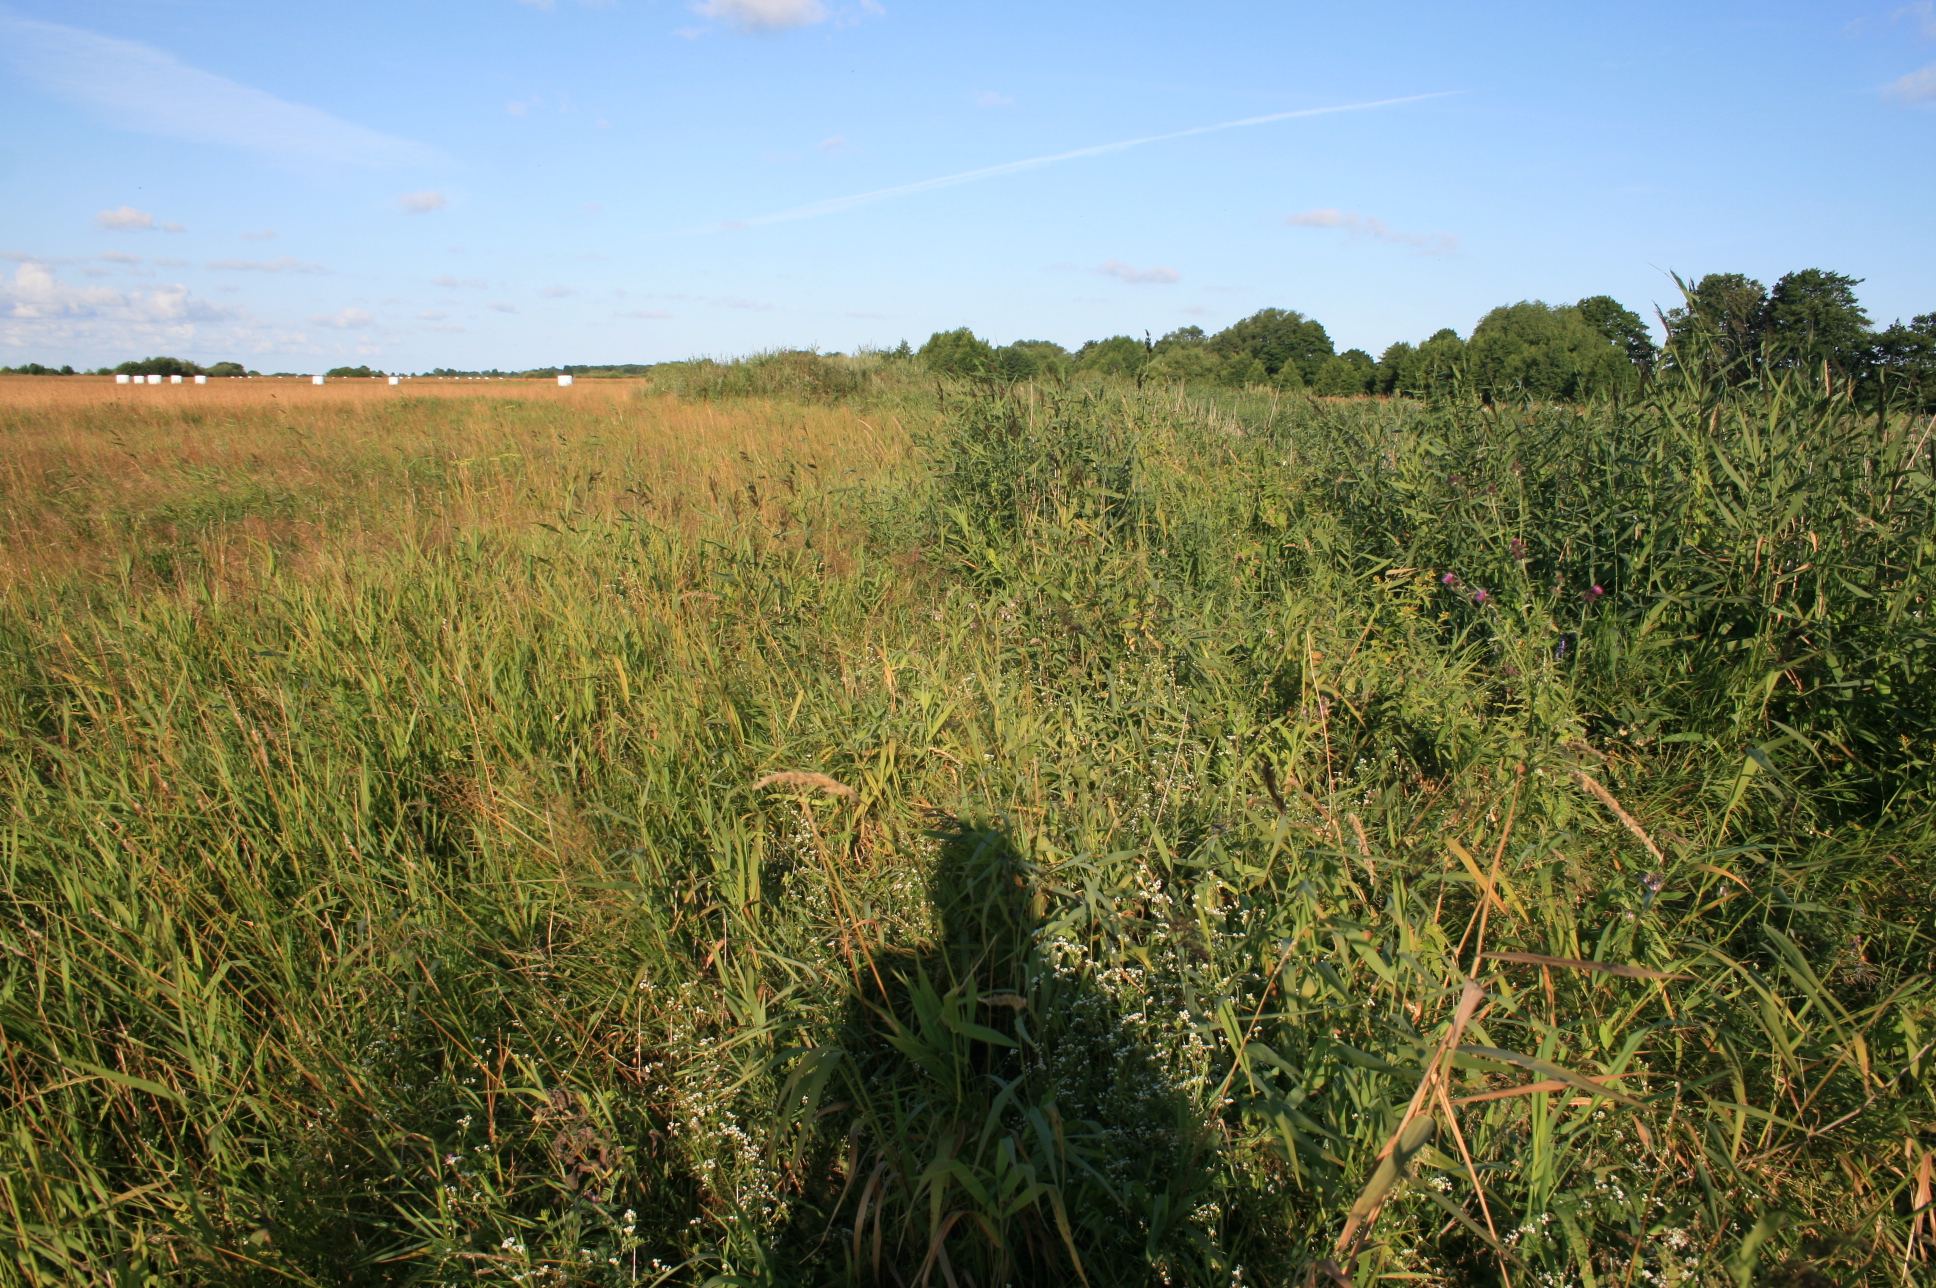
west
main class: Grassland
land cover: Spontaneously vegetated surfaces
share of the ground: > 75 %
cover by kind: herbaceous plants 100 %
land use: Semi-natural and natural areas not in use
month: July
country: LT
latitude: 55.3428
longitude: 21.2859
